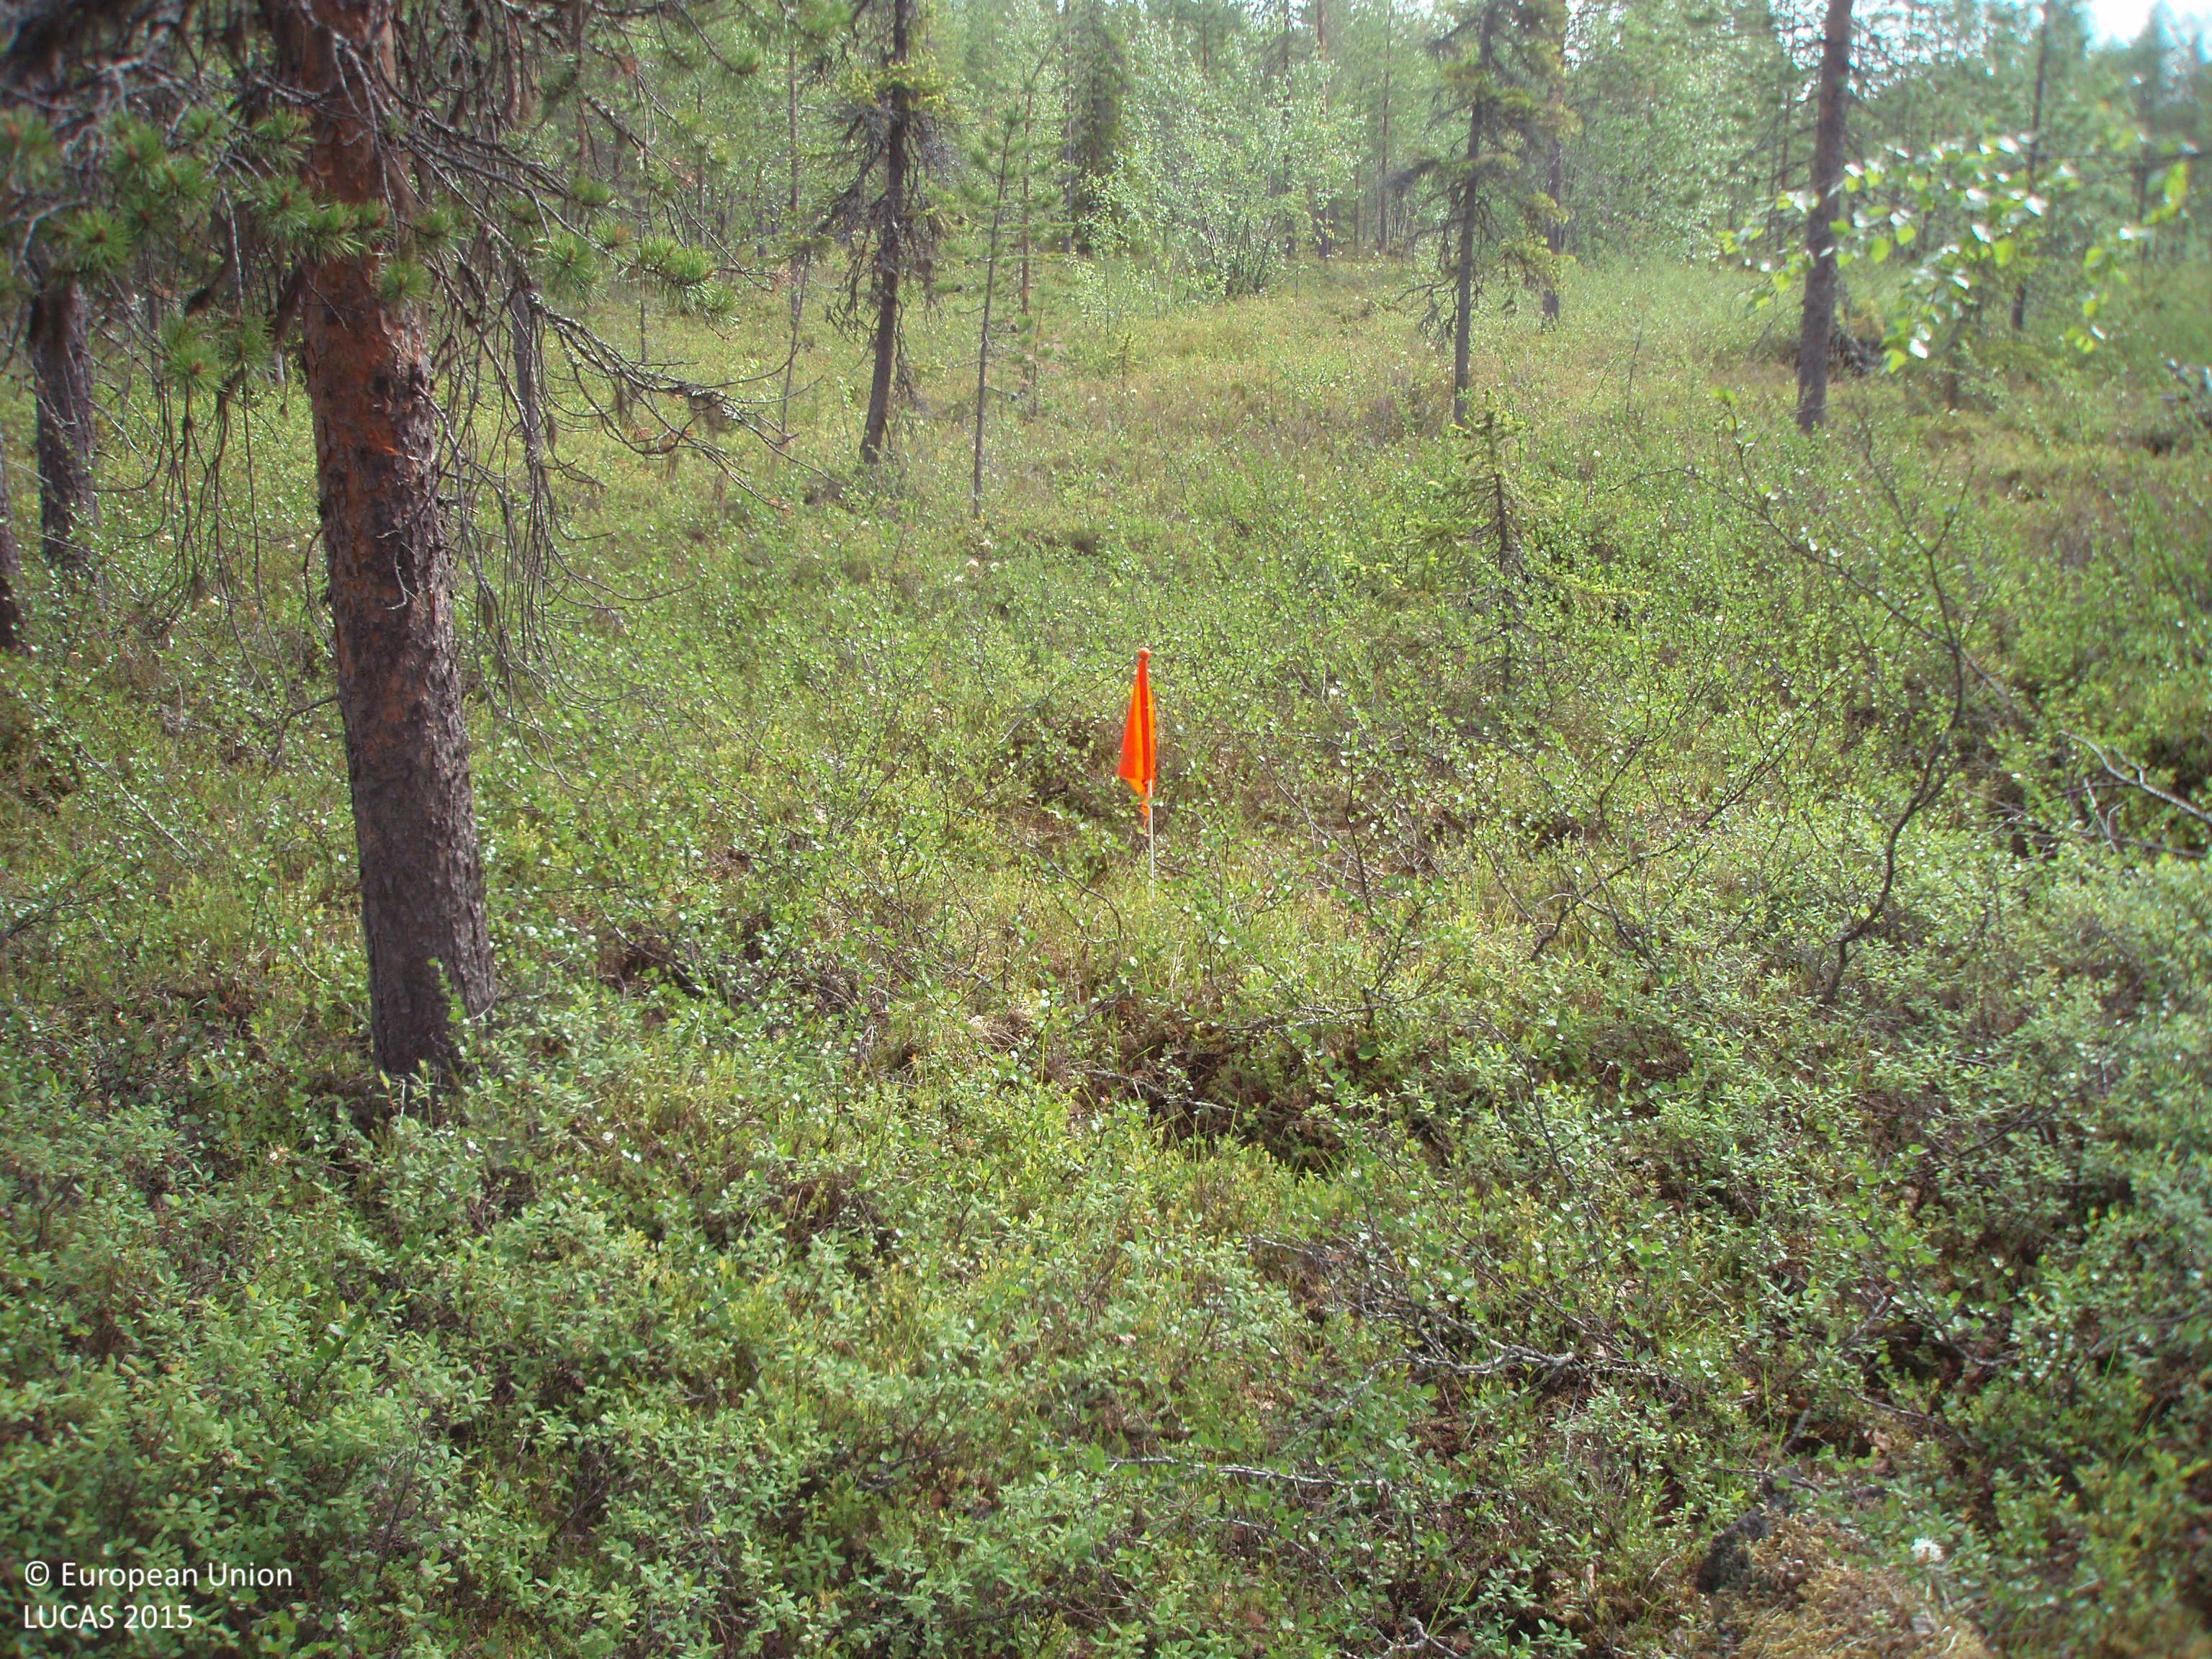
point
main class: Woodland
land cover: Pine dominated coniferous woodland
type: boreal forest
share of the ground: 50 - 75 %
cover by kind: coniferous forest trees 50 %, shrubs 40 %, broadleaved forest trees 10 %
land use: Forestry
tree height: > 5 m
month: July
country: FI
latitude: 67.8245
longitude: 27.7875
